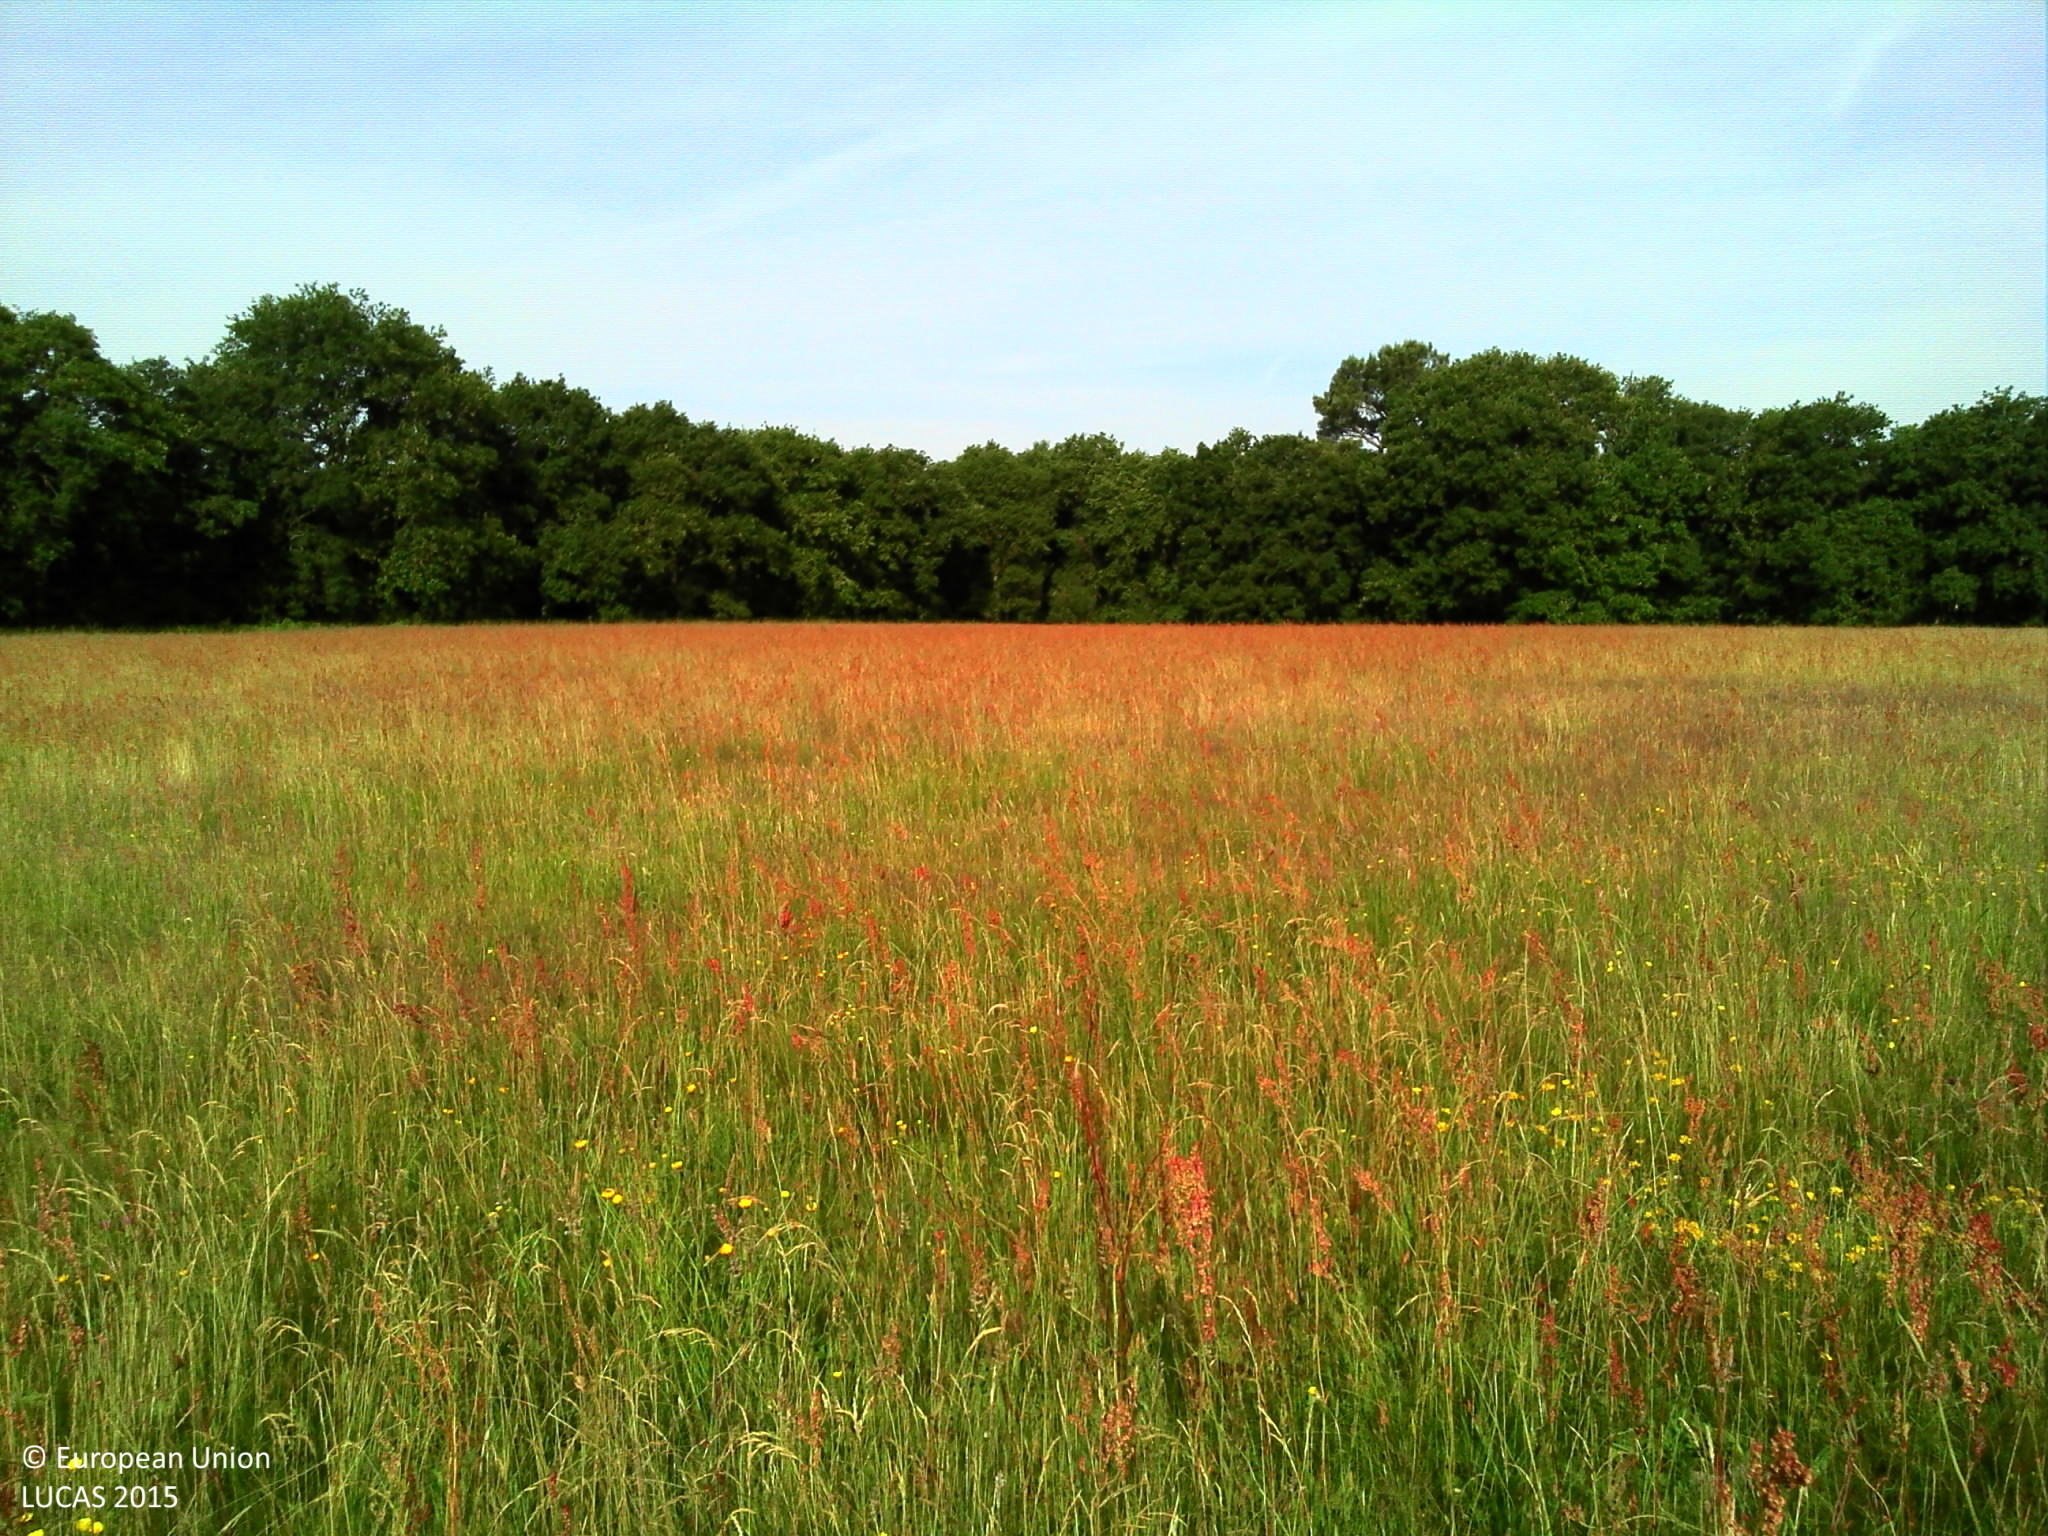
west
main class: Grassland
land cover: Grassland without tree/shrub cover
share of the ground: > 75 %
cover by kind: herbaceous plants 100 %
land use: Agriculture (excluding fallow land and kitchen gardens)
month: June
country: FR
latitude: 49.2052
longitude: -1.4541
